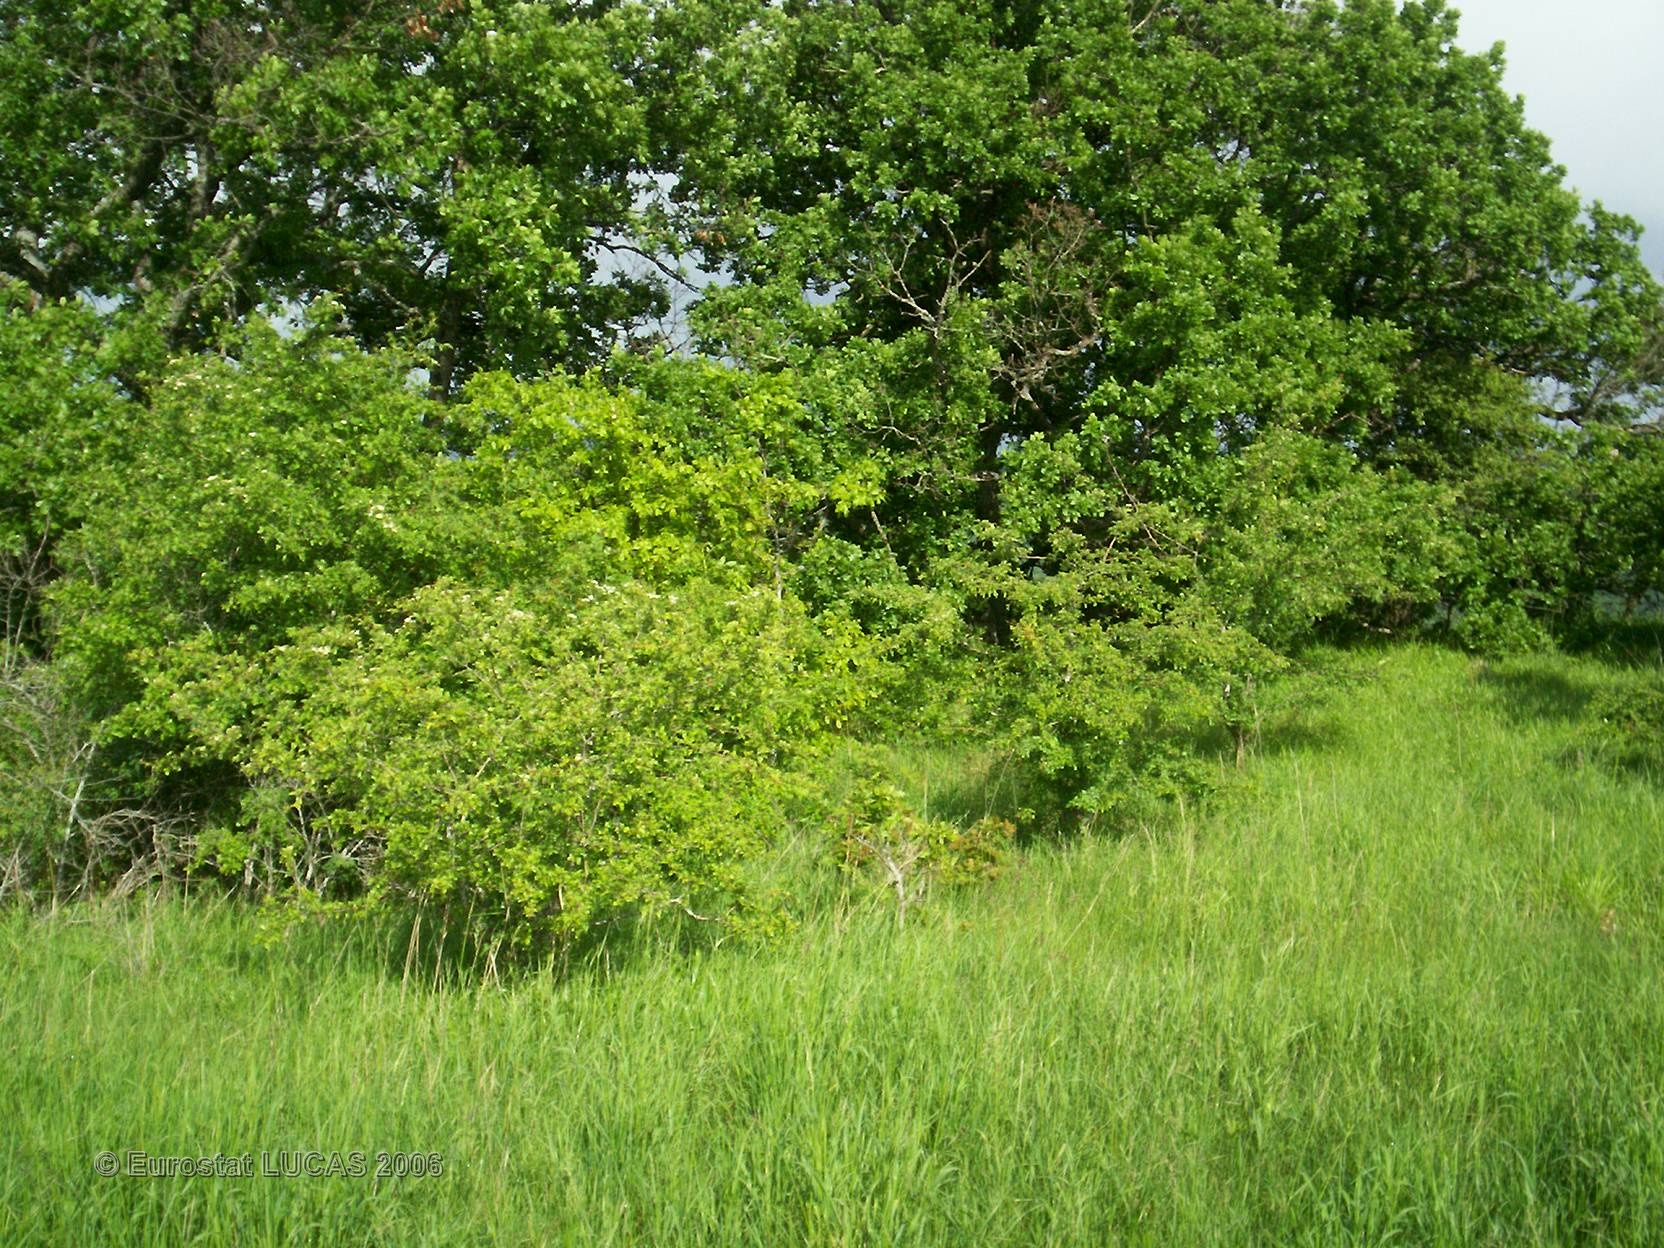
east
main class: Cropland
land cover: Common wheat
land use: Agriculture (excluding fallow land and kitchen gardens)
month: May
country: FR
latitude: 46.9766
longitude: 4.6767
